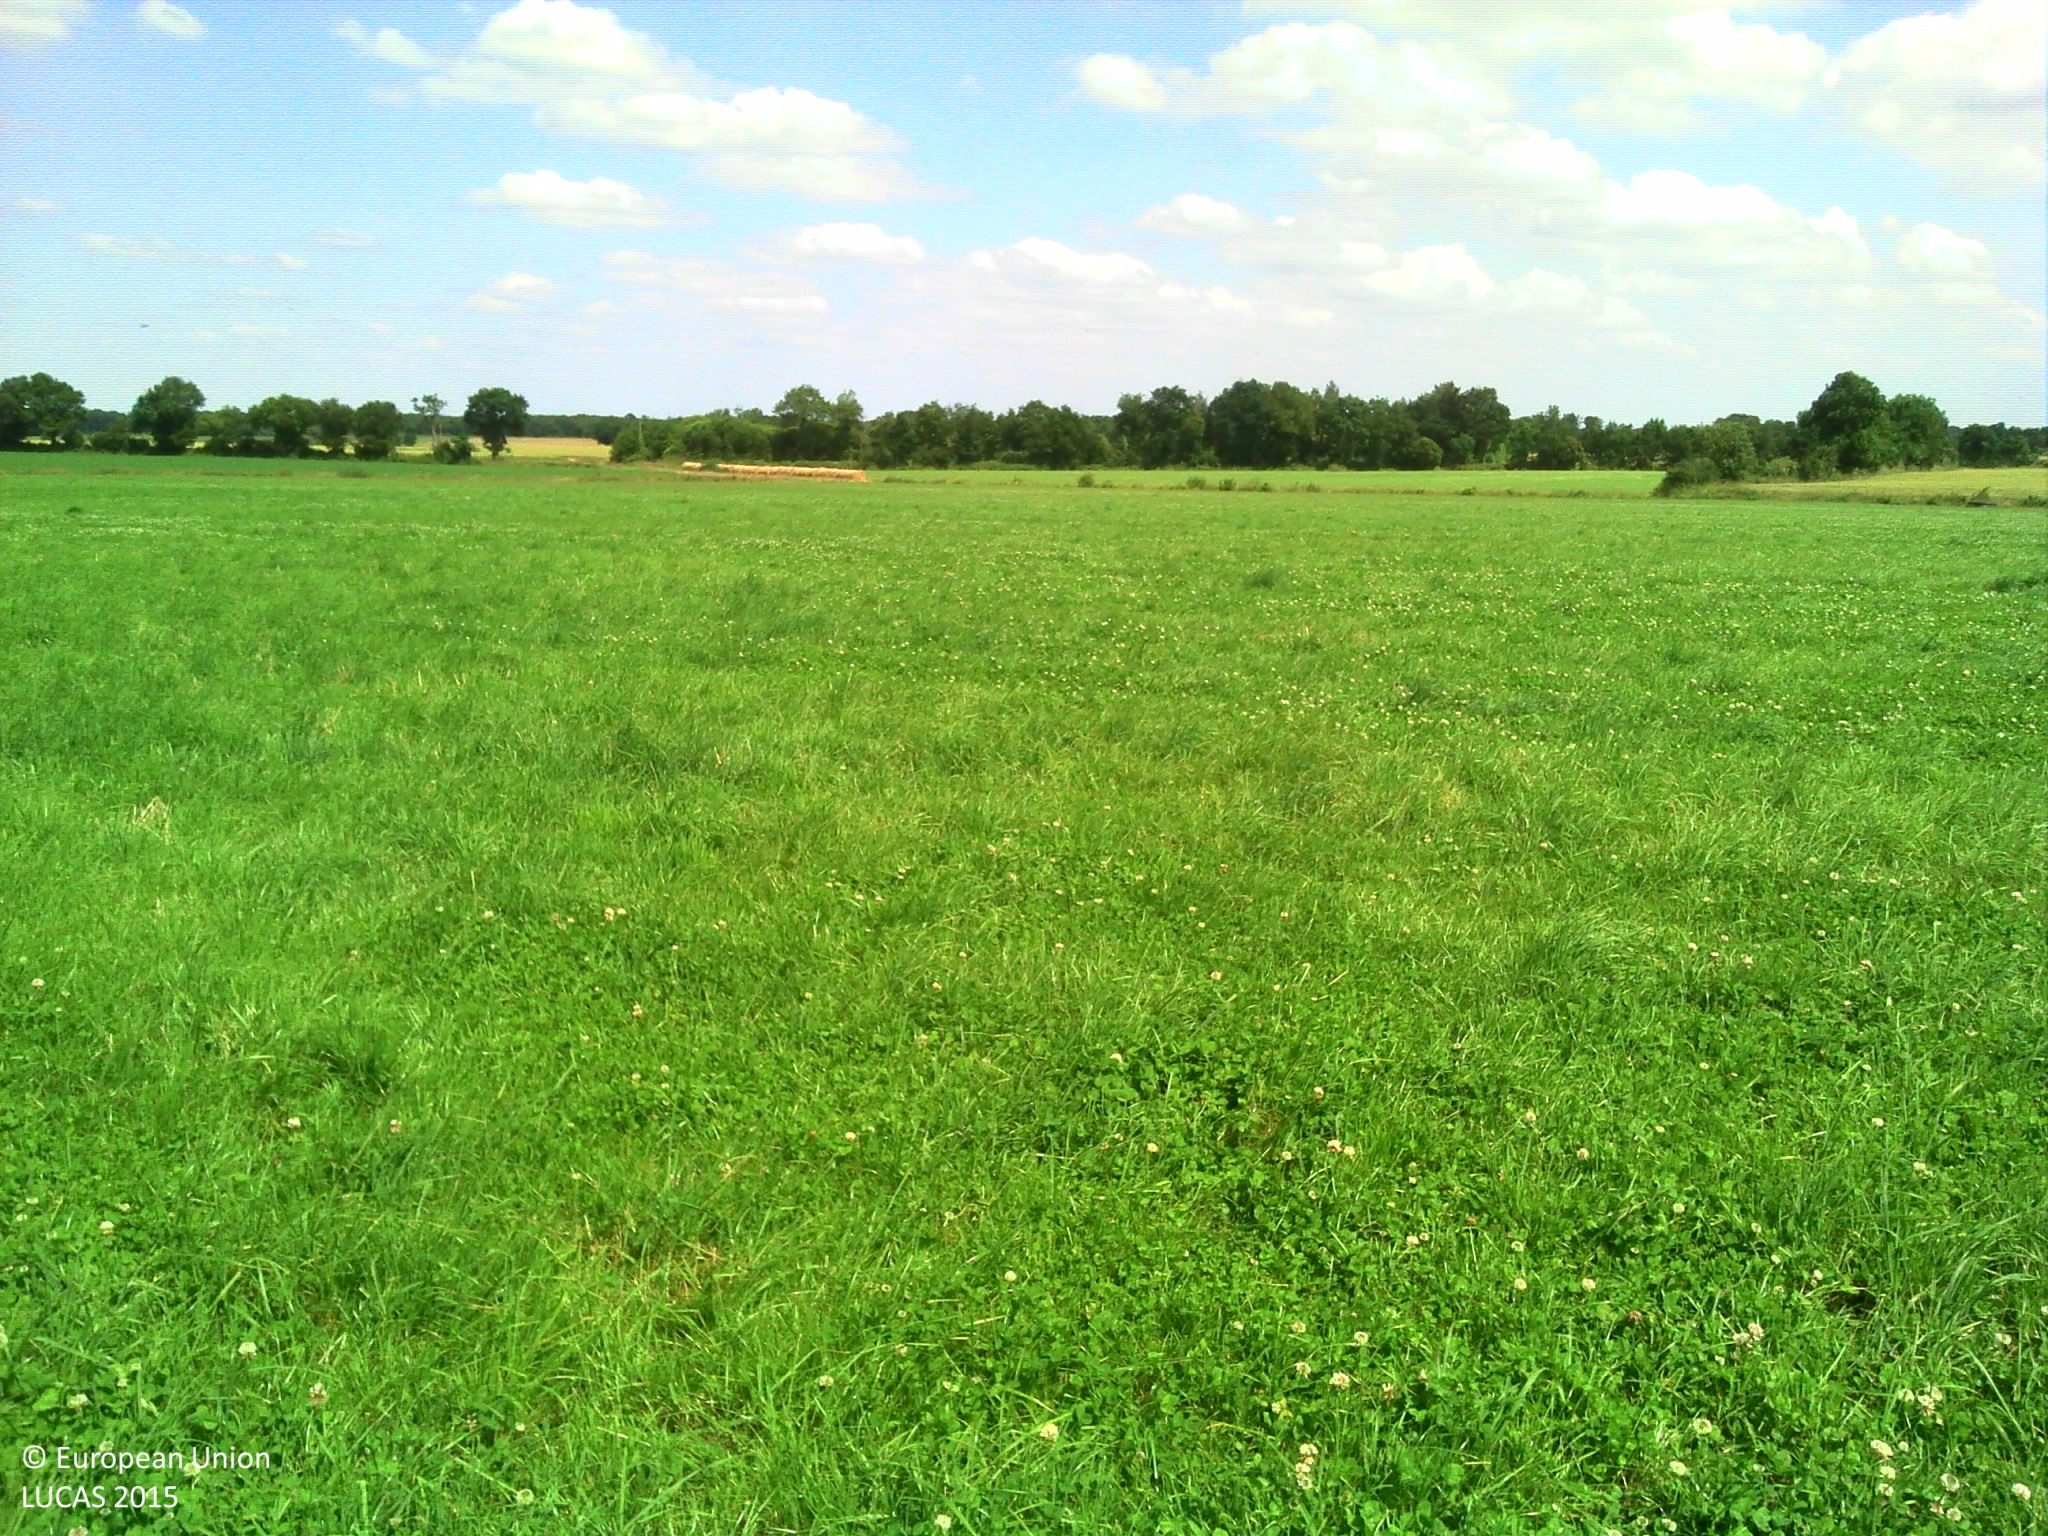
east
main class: Cropland
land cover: Temporary grasslands
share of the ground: > 75 %
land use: Agriculture (excluding fallow land and kitchen gardens)
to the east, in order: Temporary grasslands; Fences; Ditches and canals; Maize
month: June
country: FR
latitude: 46.8627
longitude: -1.4381
